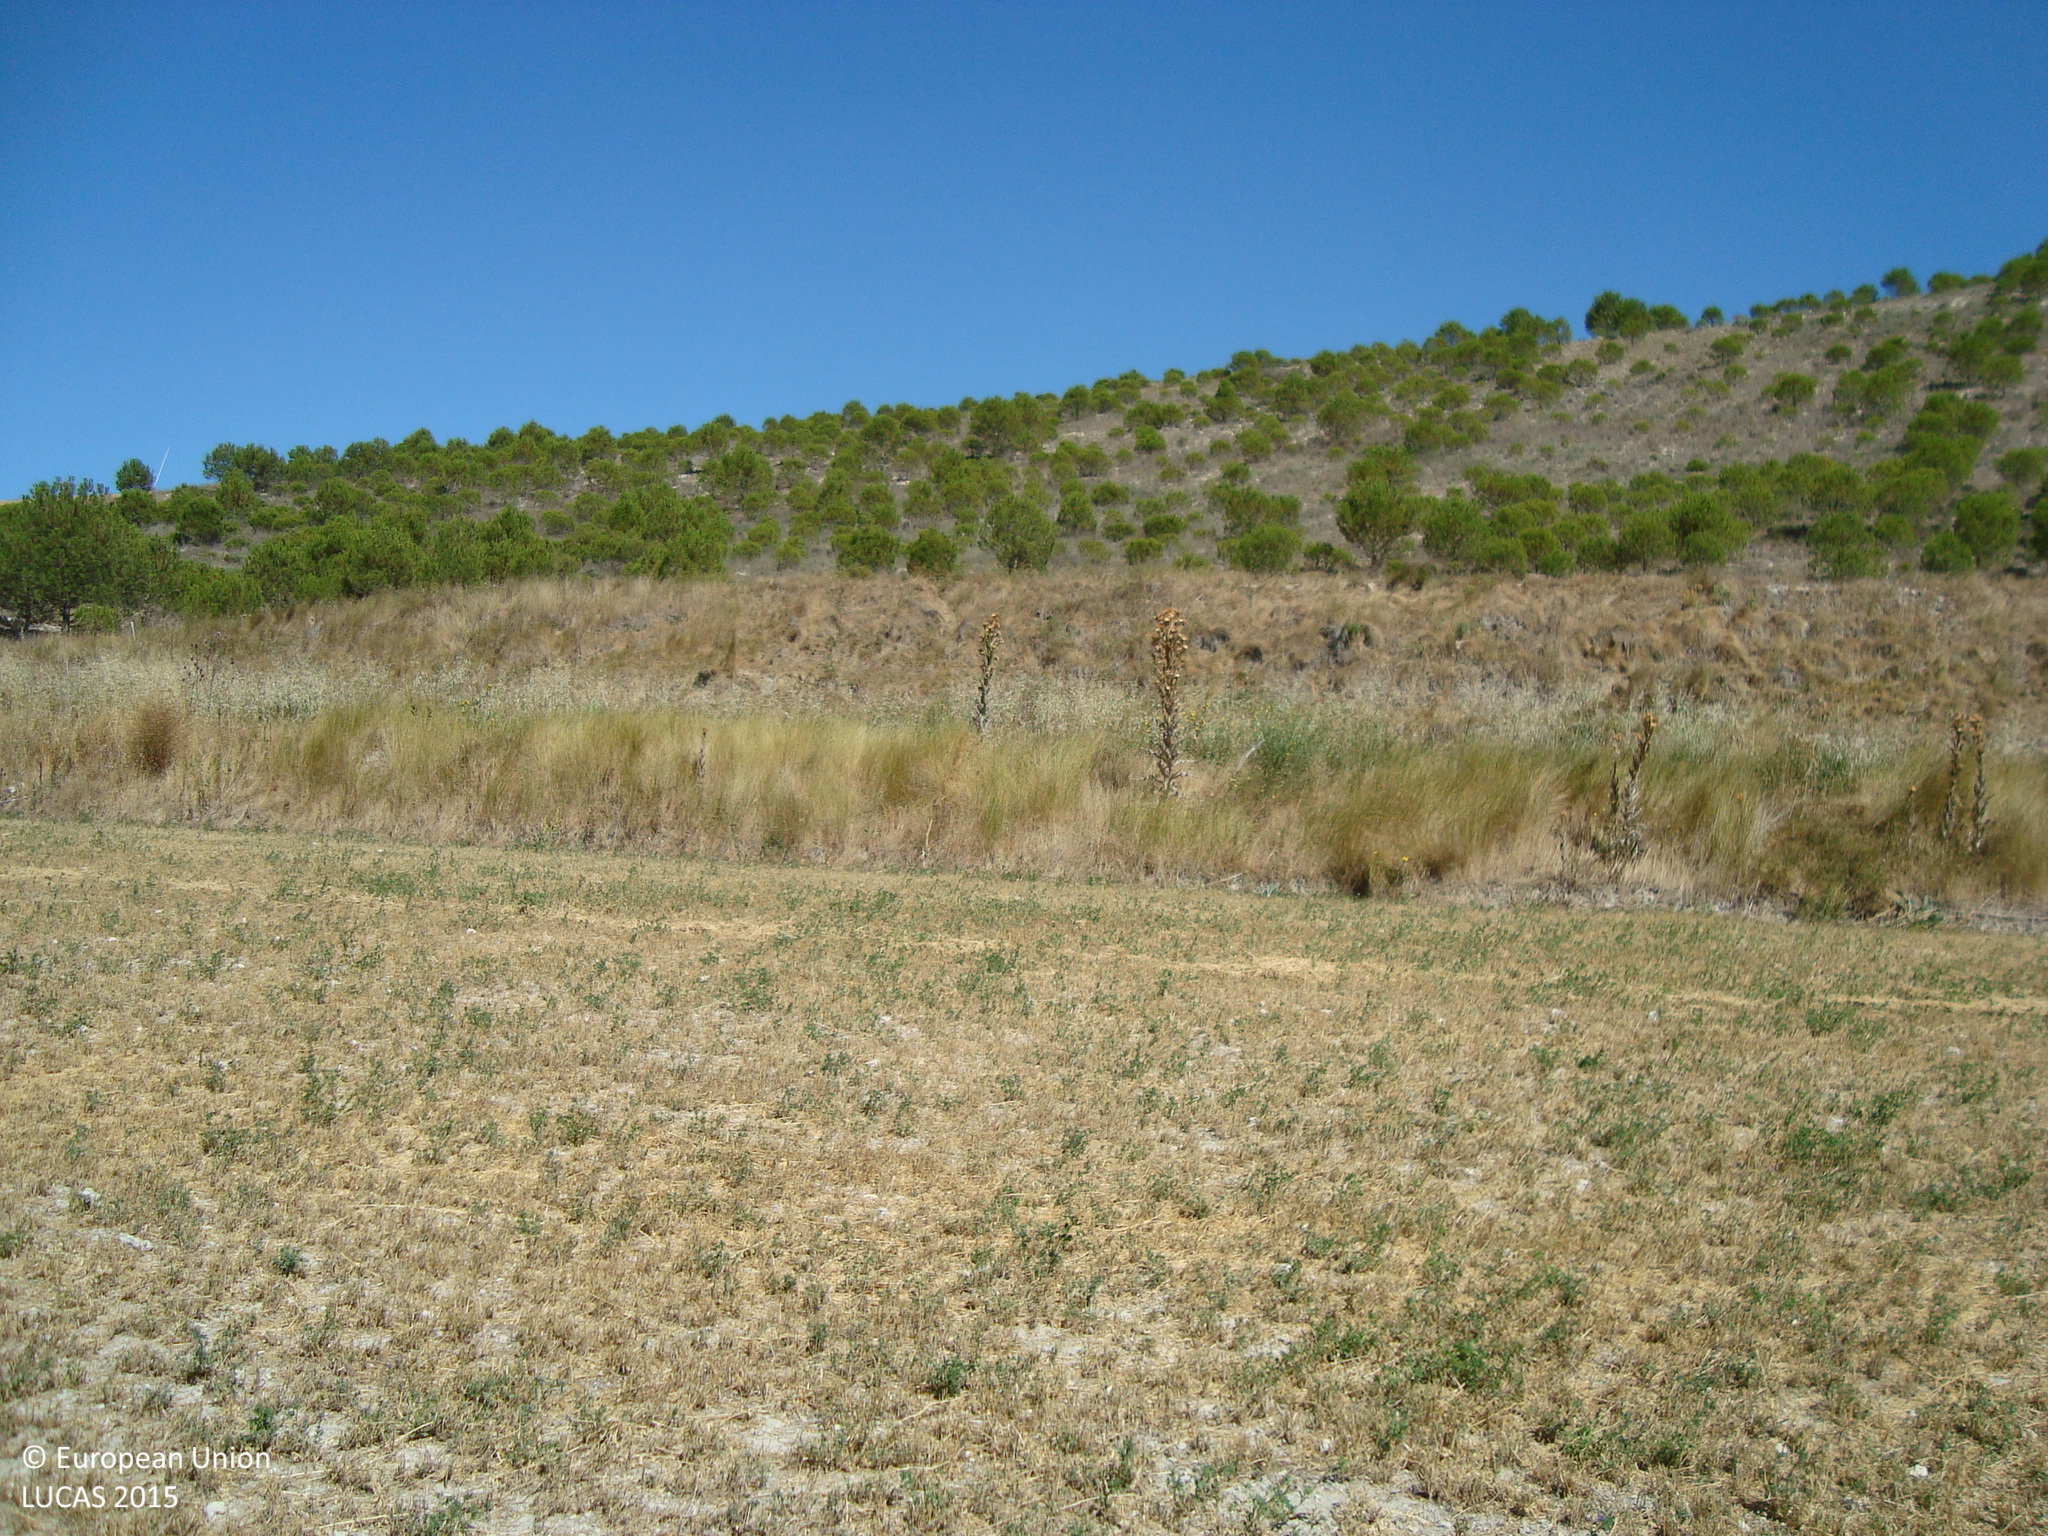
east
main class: Cropland
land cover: Lucerne
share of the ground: > 75 %
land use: Agriculture (excluding fallow land and kitchen gardens)
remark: Harvested field
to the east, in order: Lucerne; Grassland without tree/shrub cover; Paved roads, cycling and walking lanes; Ditches and canals; Grassland without tree/shrub cover; Barley; Pine dominated coniferous woodland; Barley
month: August
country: ES
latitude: 42.1862
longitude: -4.1476
